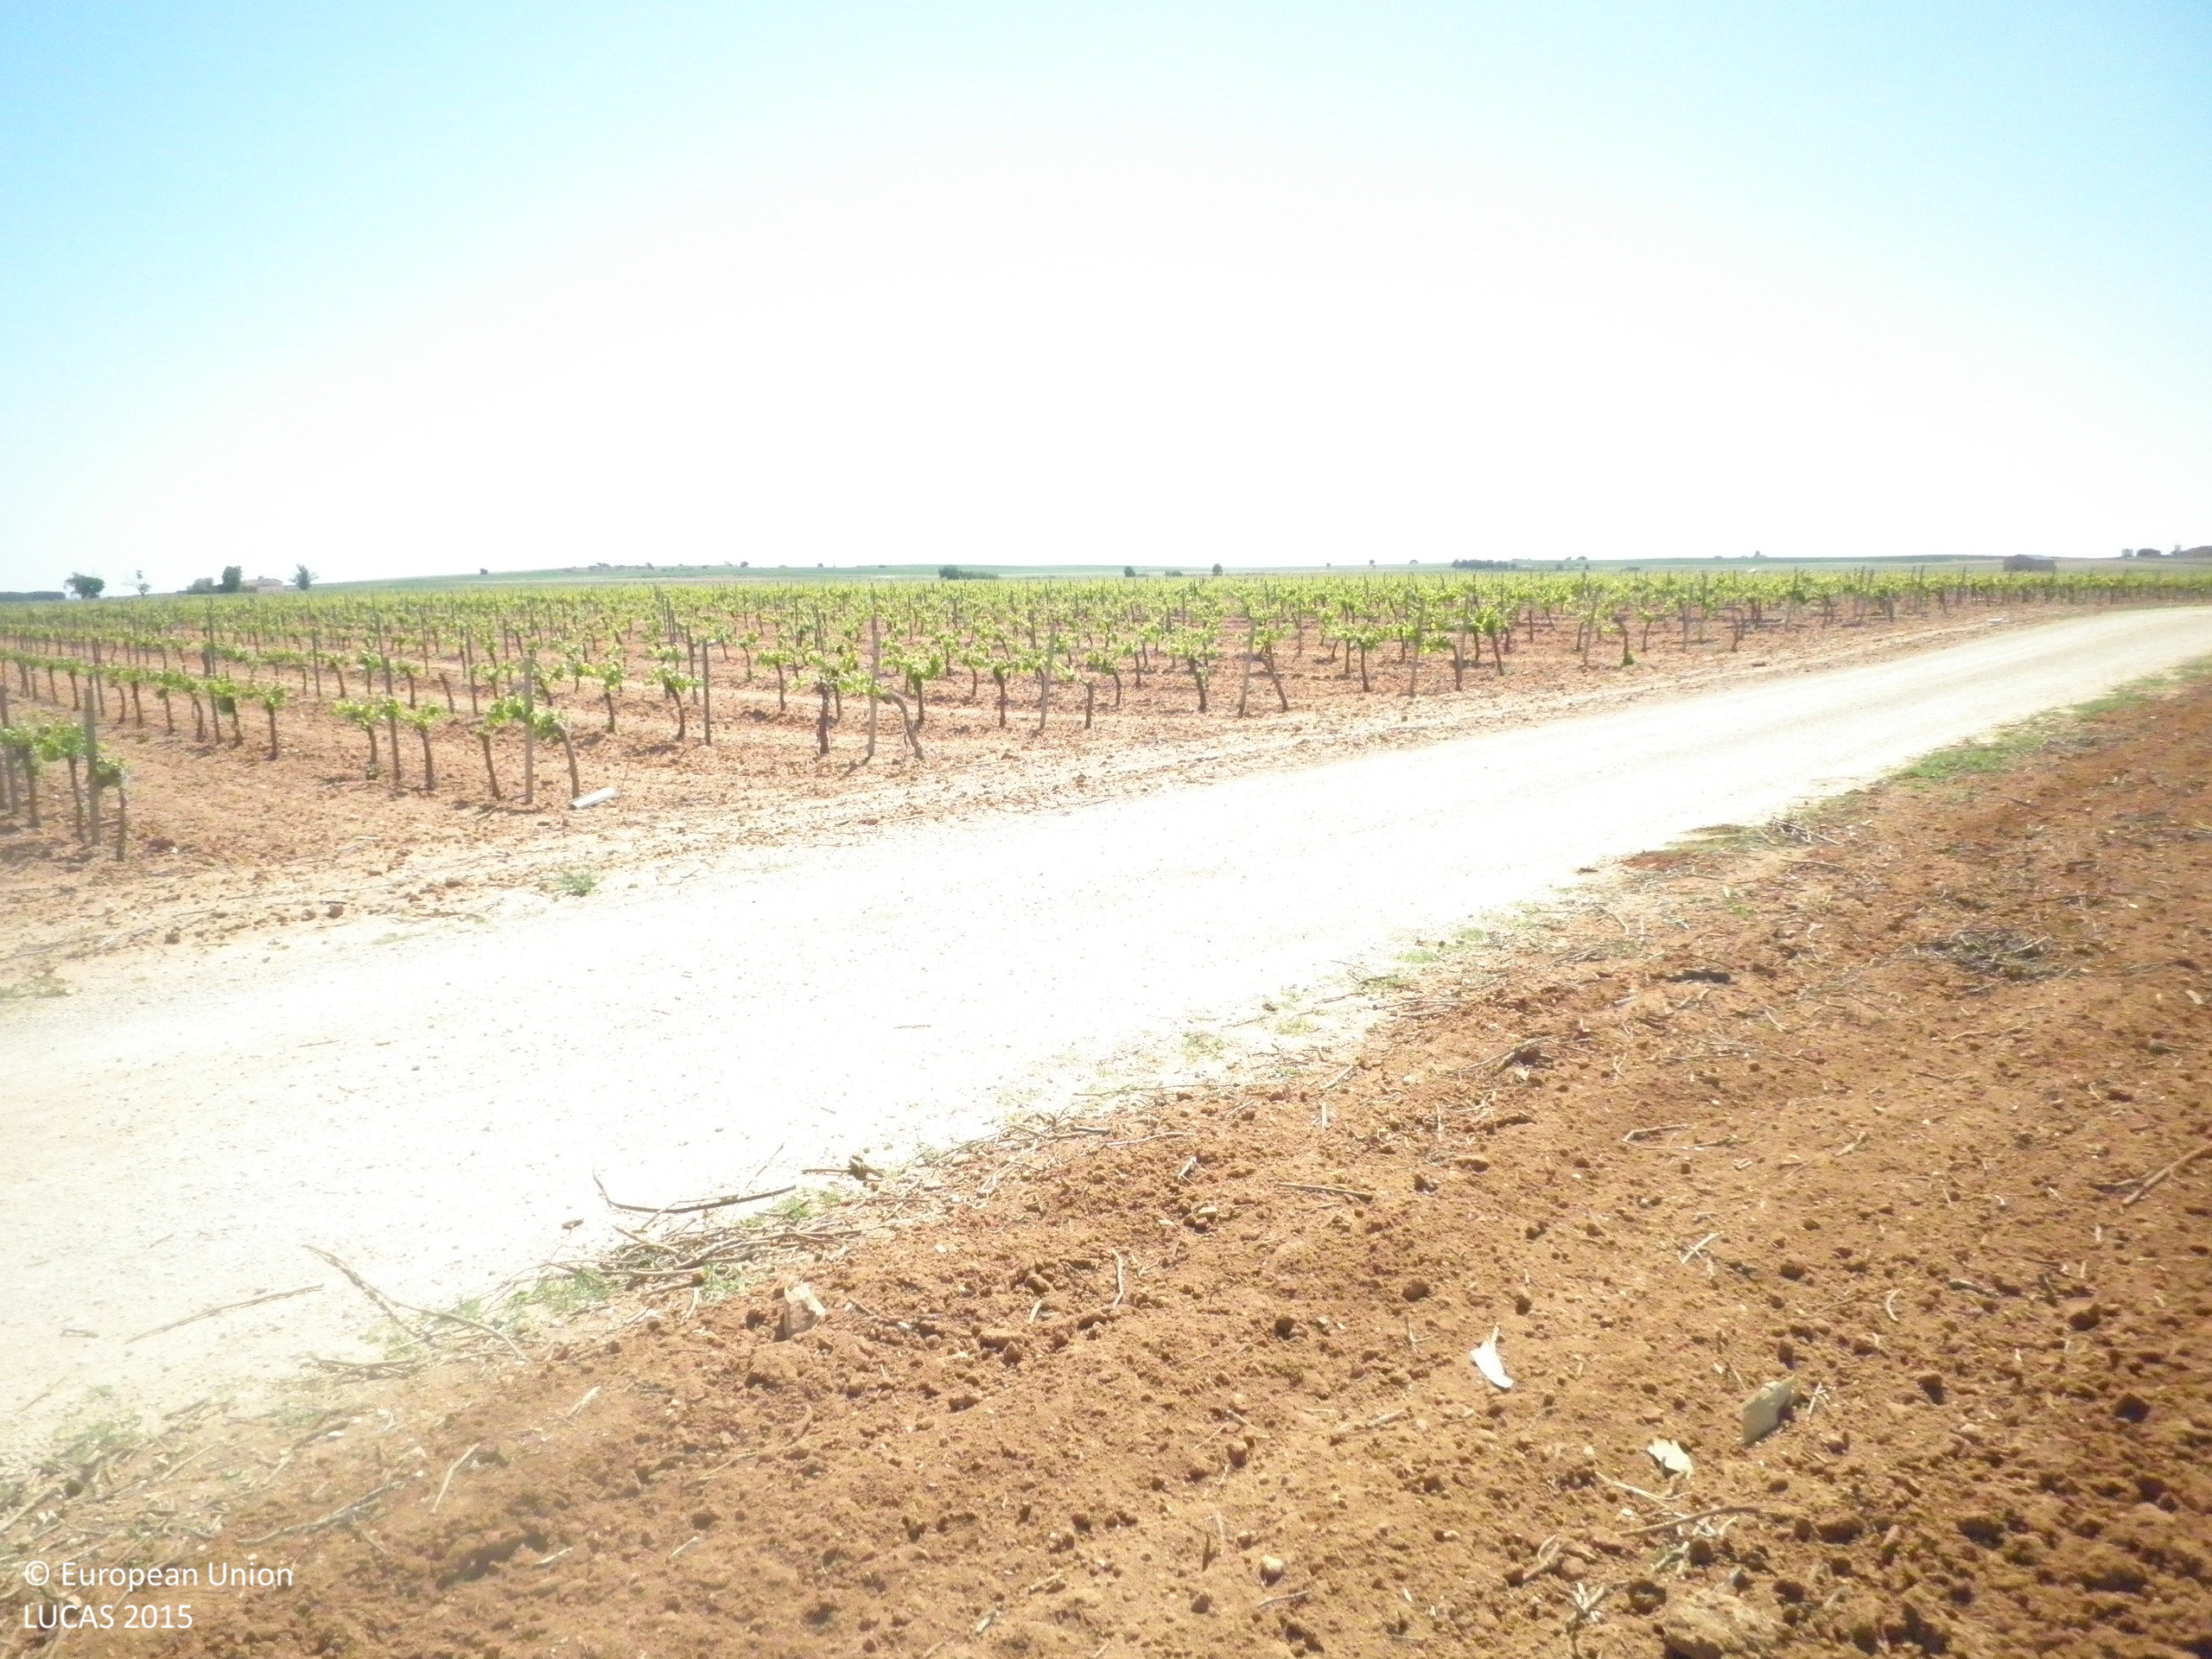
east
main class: Cropland
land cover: Vineyards
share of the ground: < 10 %
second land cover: Other bare soil
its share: > 75 %
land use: Agriculture (excluding fallow land and kitchen gardens)
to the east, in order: Vineyards; Other bare soil; Tracks; Vineyards; Other bare soil; Vineyards
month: May
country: ES
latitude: 39.4277
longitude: -2.7809
